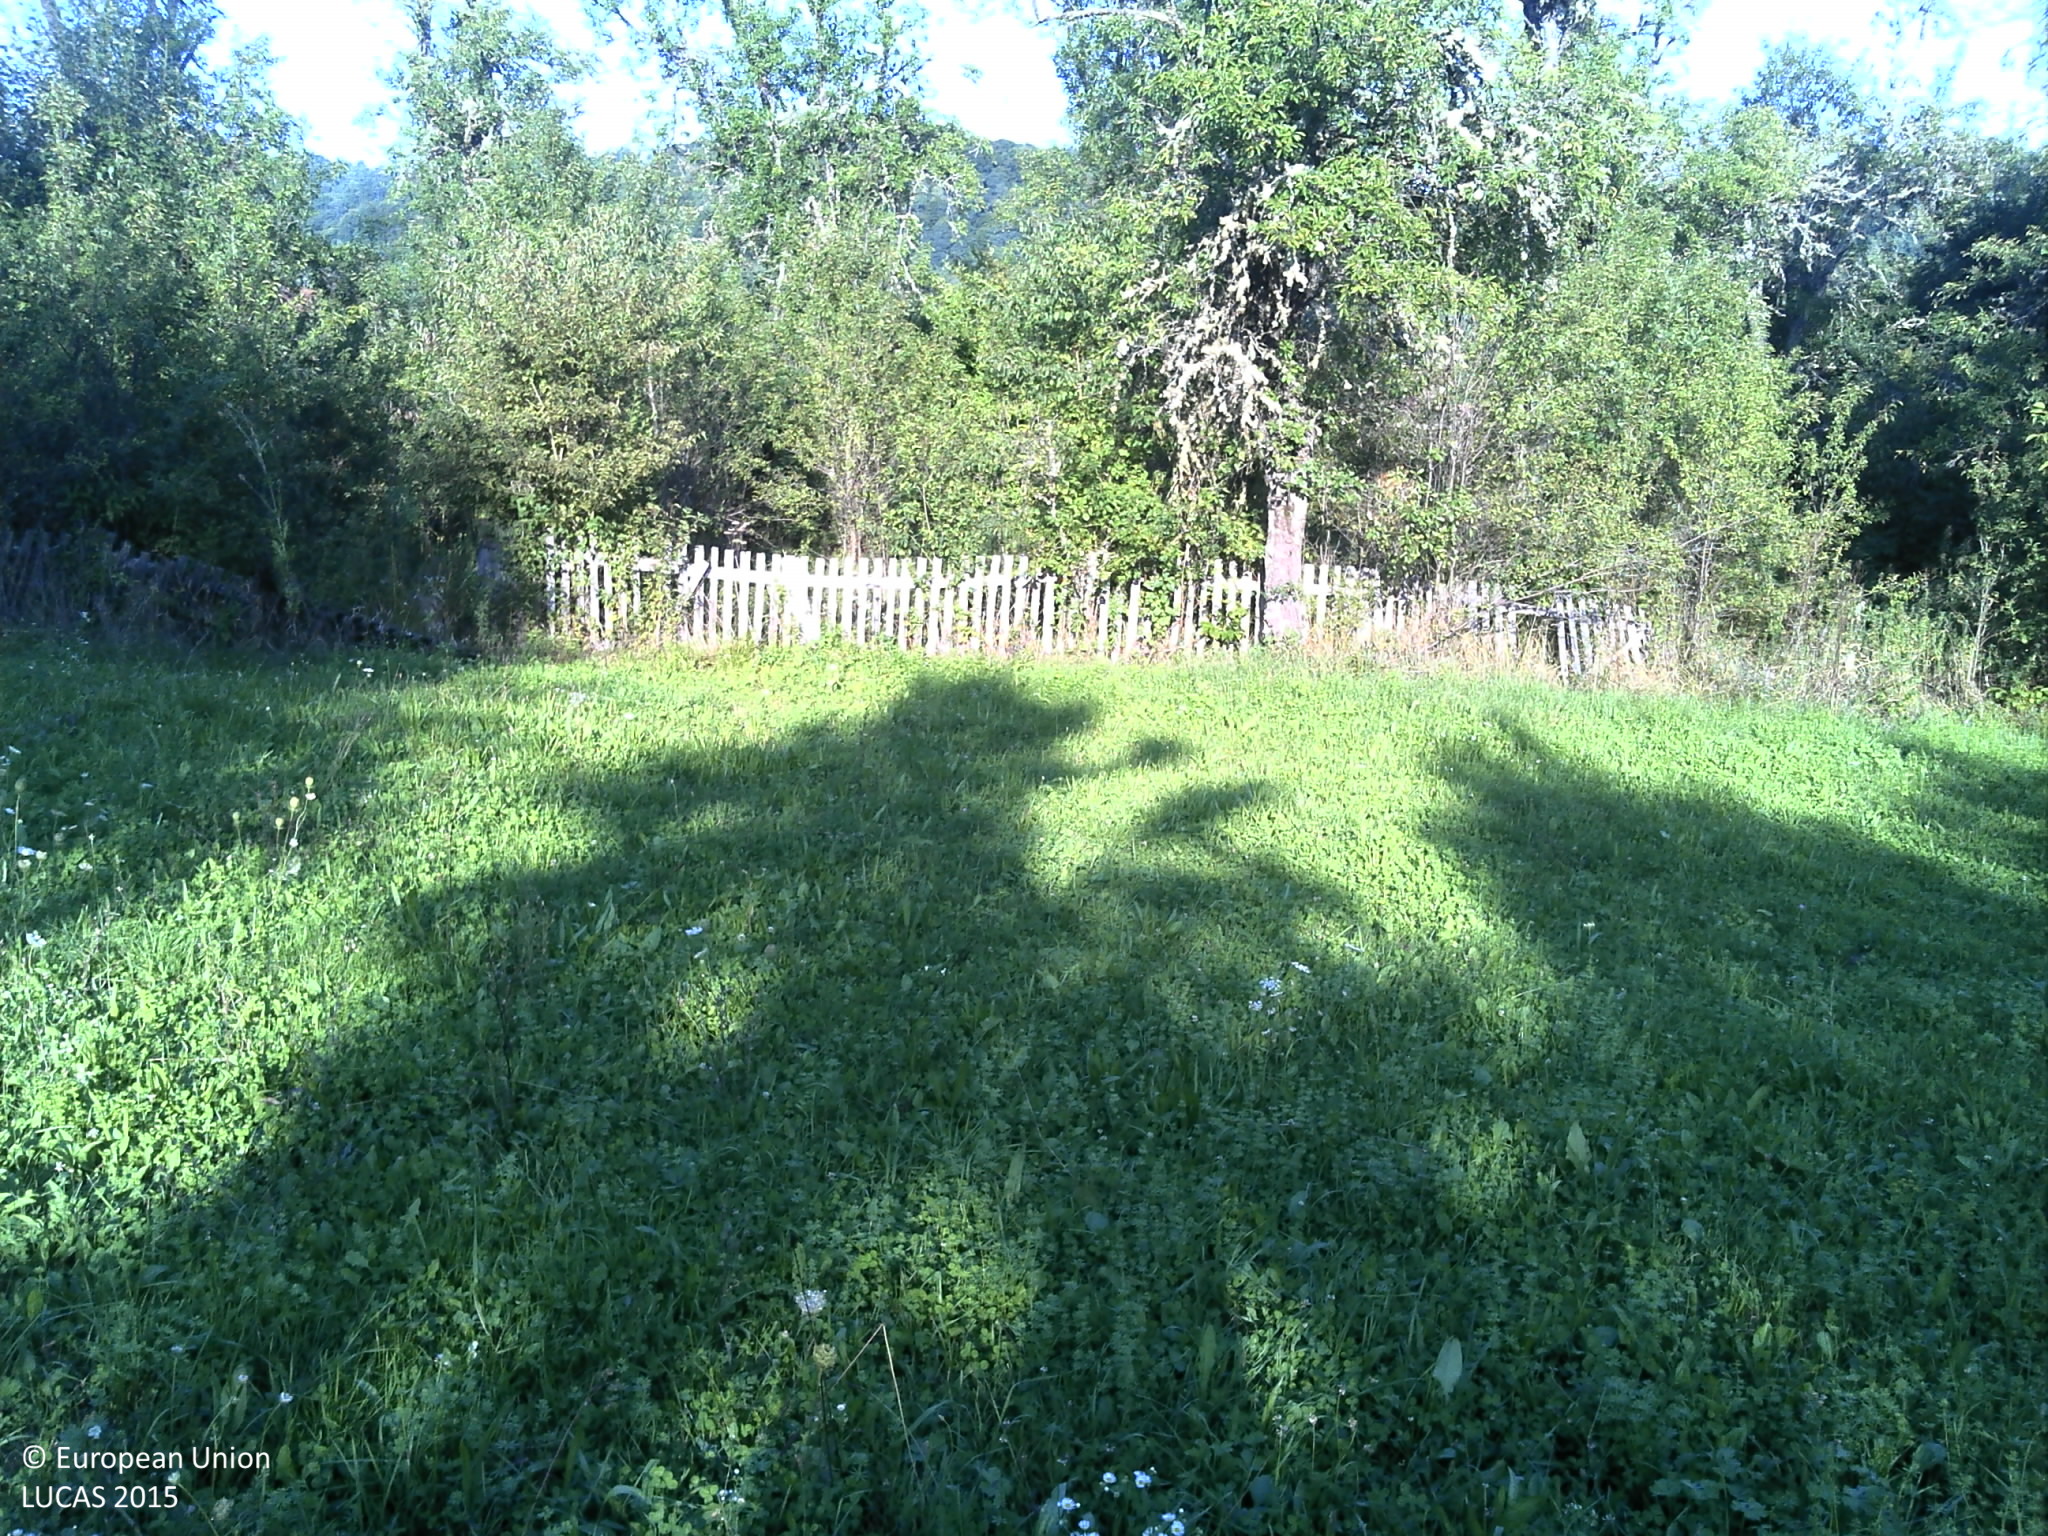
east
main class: Grassland
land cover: Spontaneously vegetated surfaces
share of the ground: > 75 %
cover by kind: herbaceous plants 100 %
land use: Semi-natural and natural areas not in use
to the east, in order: Spontaneously vegetated surfaces; Artificial constructions in urban areas; Spontaneously vegetated surfaces; Shrubland with sparse tree cover; Spontaneously vegetated surfaces; Shrubland without tree cover; Rivers and streams; Artificial constructions in urban areas; Broadleaved woodland
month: August
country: HR
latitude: 45.1360
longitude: 16.2909
